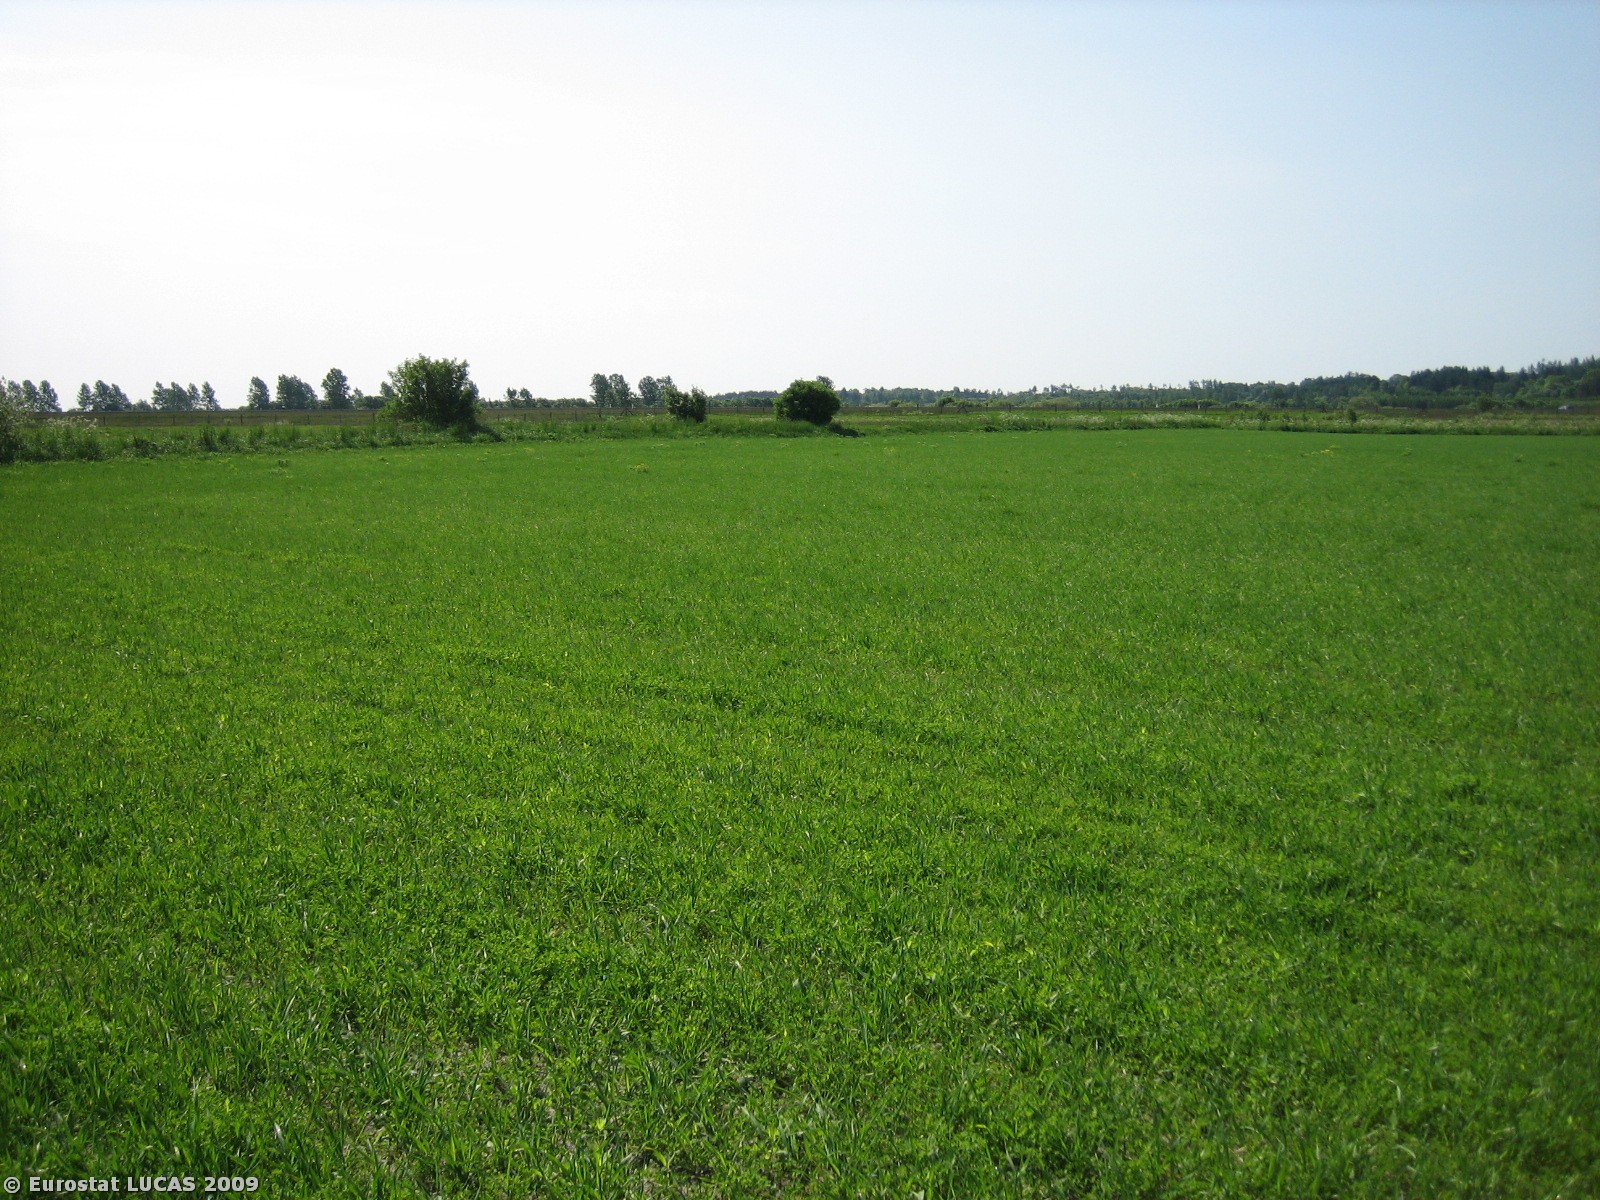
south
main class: Cropland
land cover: Barley
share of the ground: 50 - 75 %
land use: Agriculture (excluding fallow land and kitchen gardens)
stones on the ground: < 10 %
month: May
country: DK
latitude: 56.1314
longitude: 9.2125
